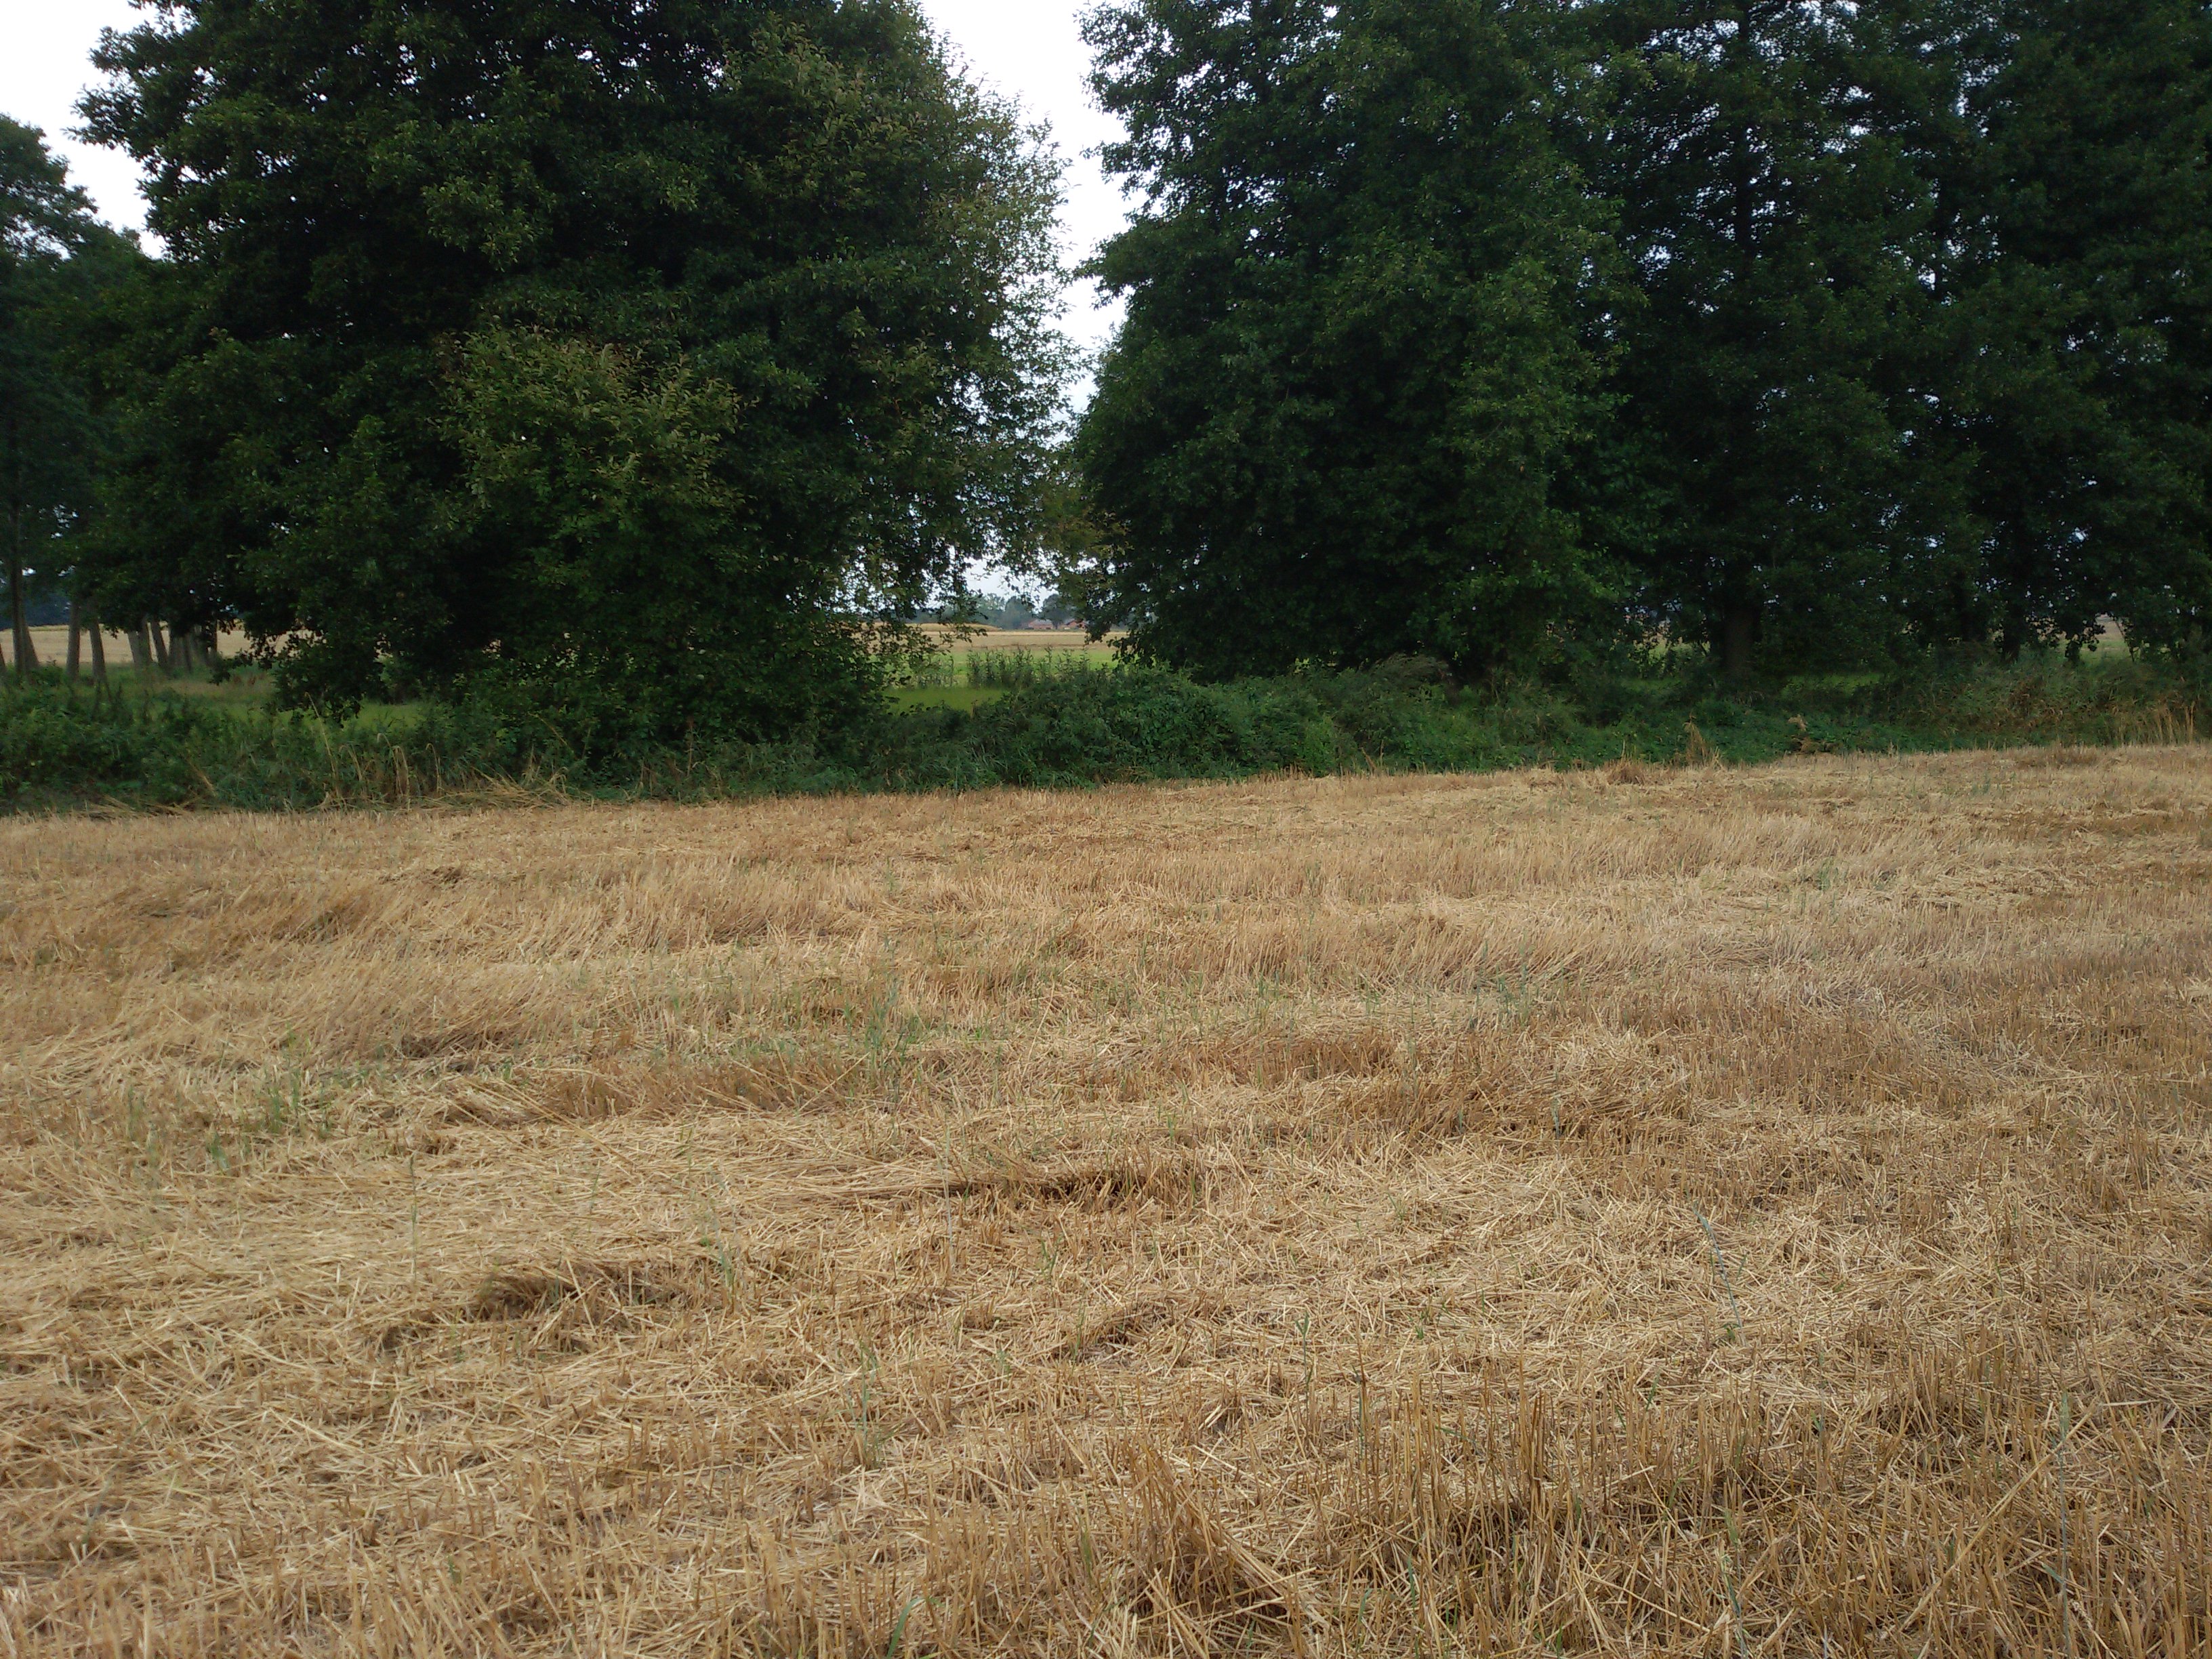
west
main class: Cropland
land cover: Common wheat
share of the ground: > 75 %
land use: Agriculture (excluding fallow land and kitchen gardens)
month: August
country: PL
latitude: 51.7183
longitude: 17.8749
